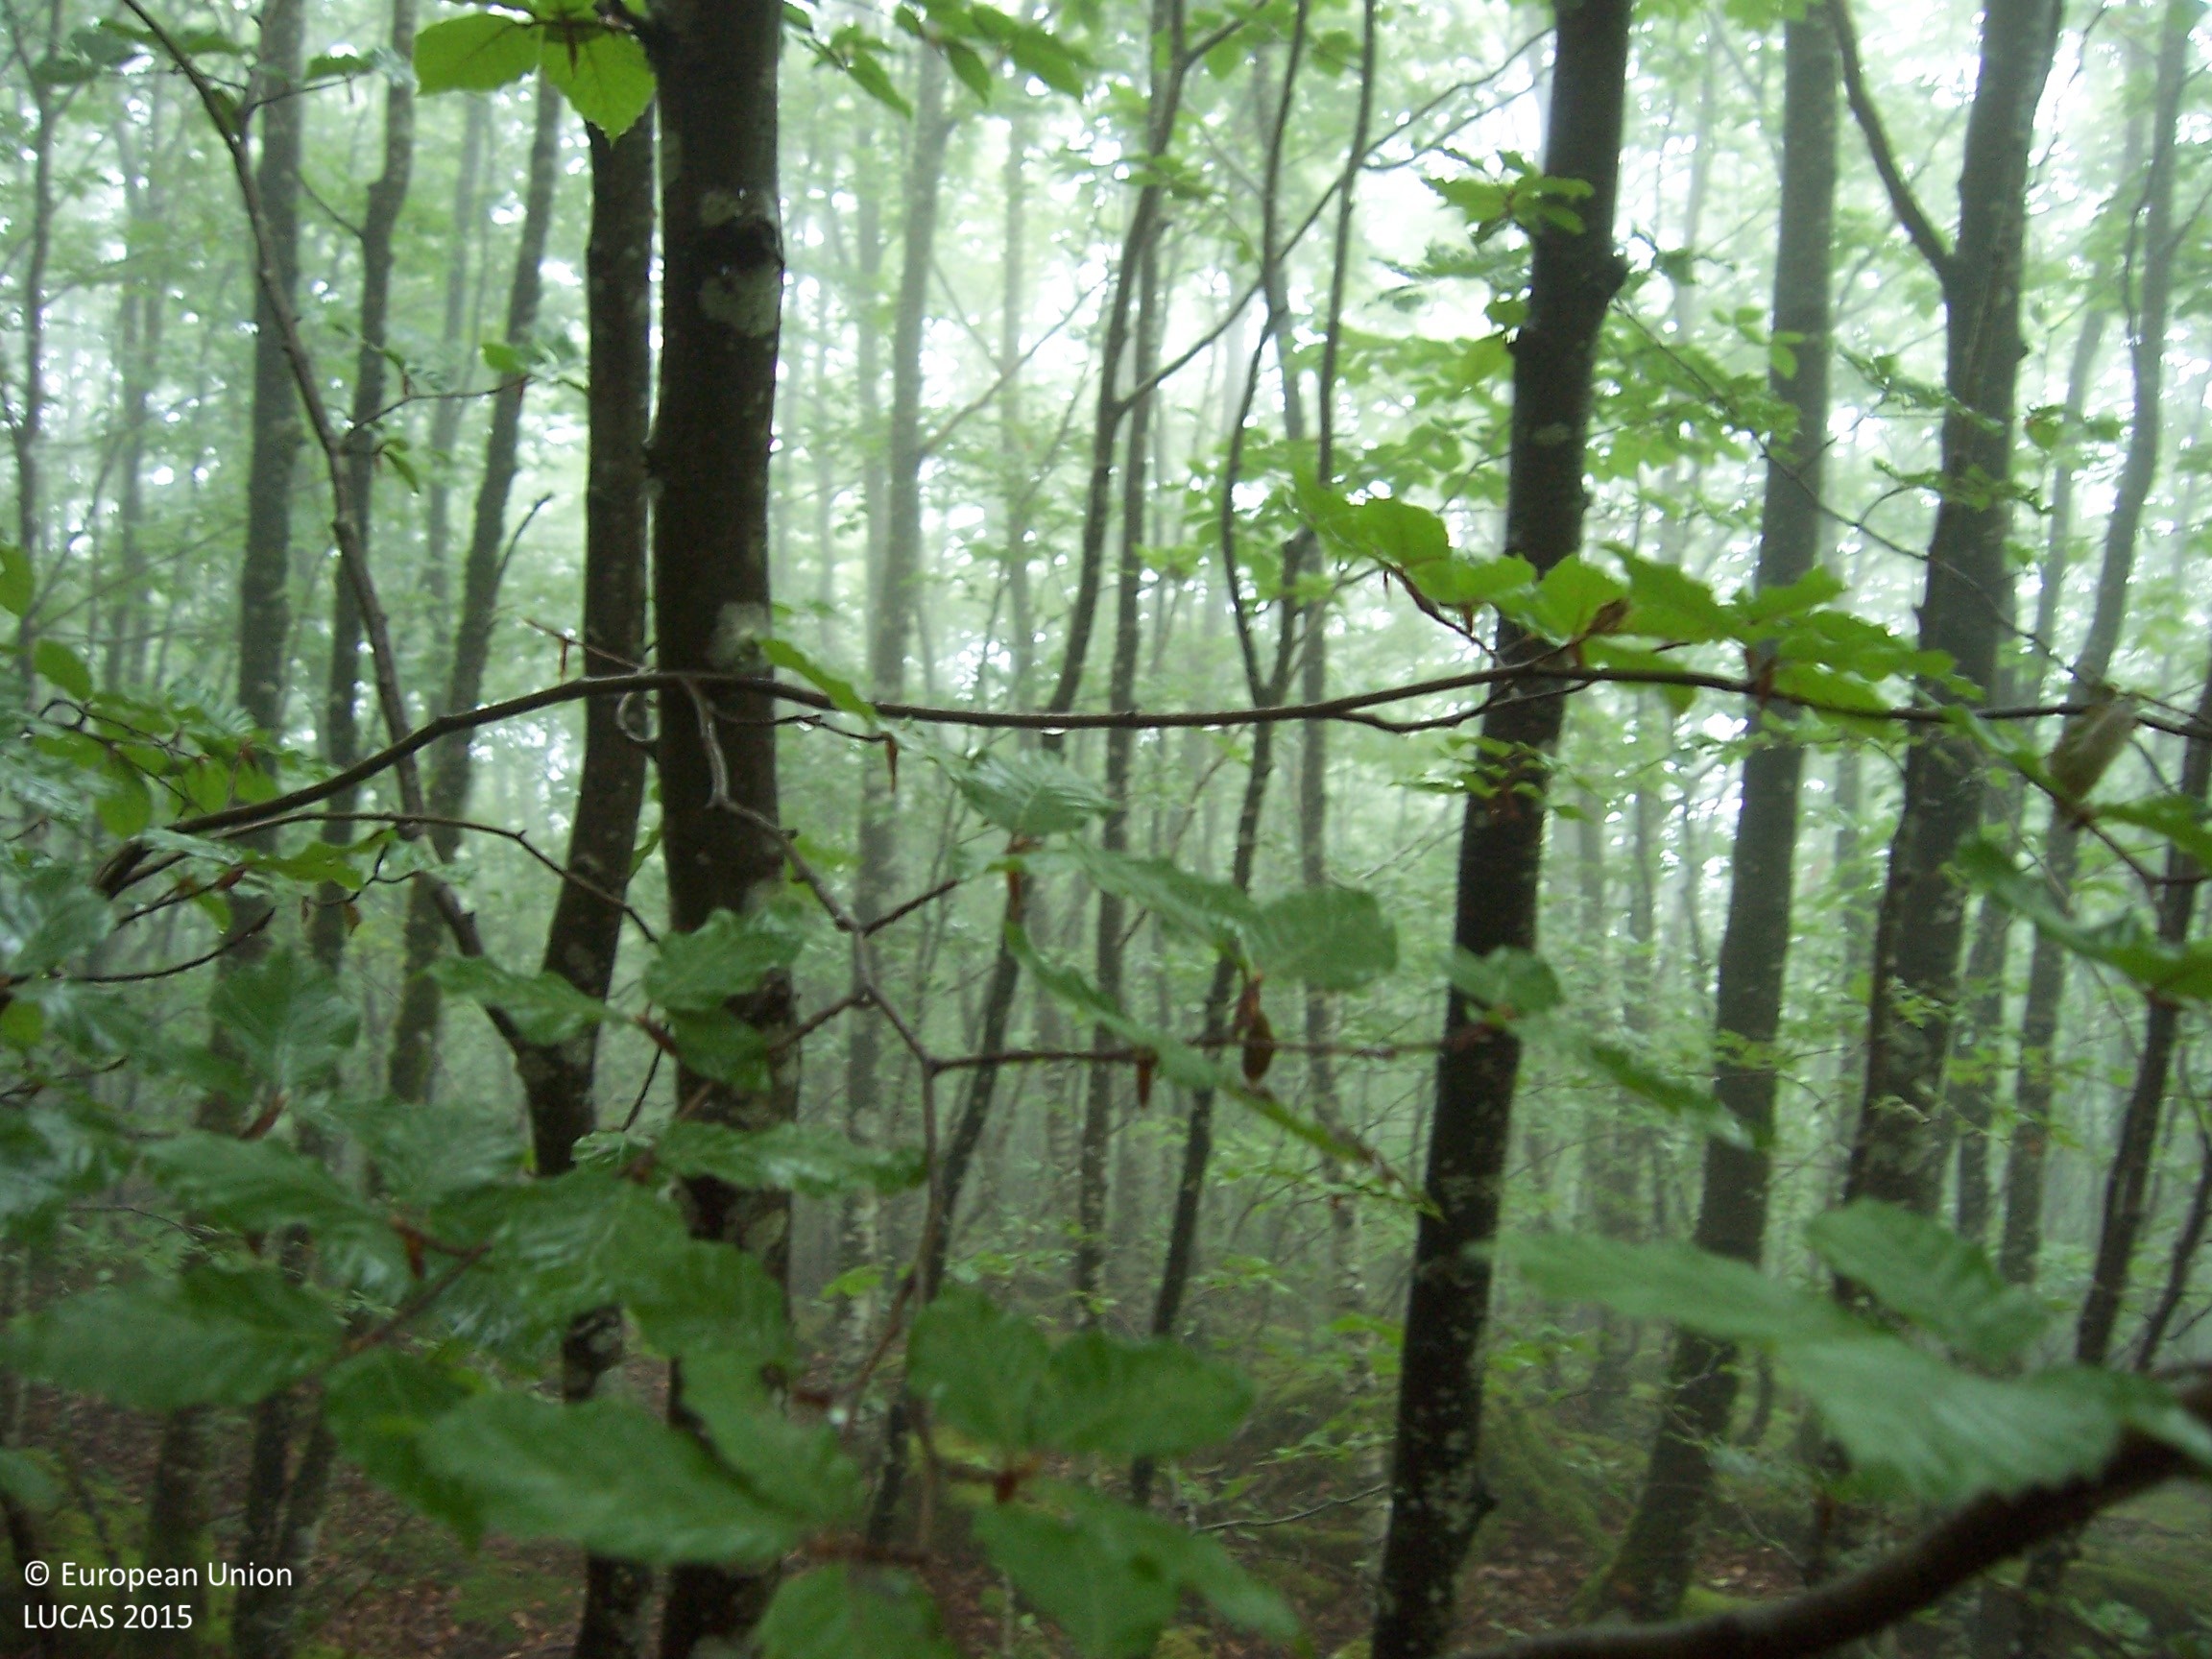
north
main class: Woodland
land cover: Broadleaved woodland
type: mountainous beech forest
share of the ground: > 75 %
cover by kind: broadleaved forest trees 100 %
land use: Forestry
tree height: > 5 m
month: July
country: ES
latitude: 43.0483
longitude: -1.2206
